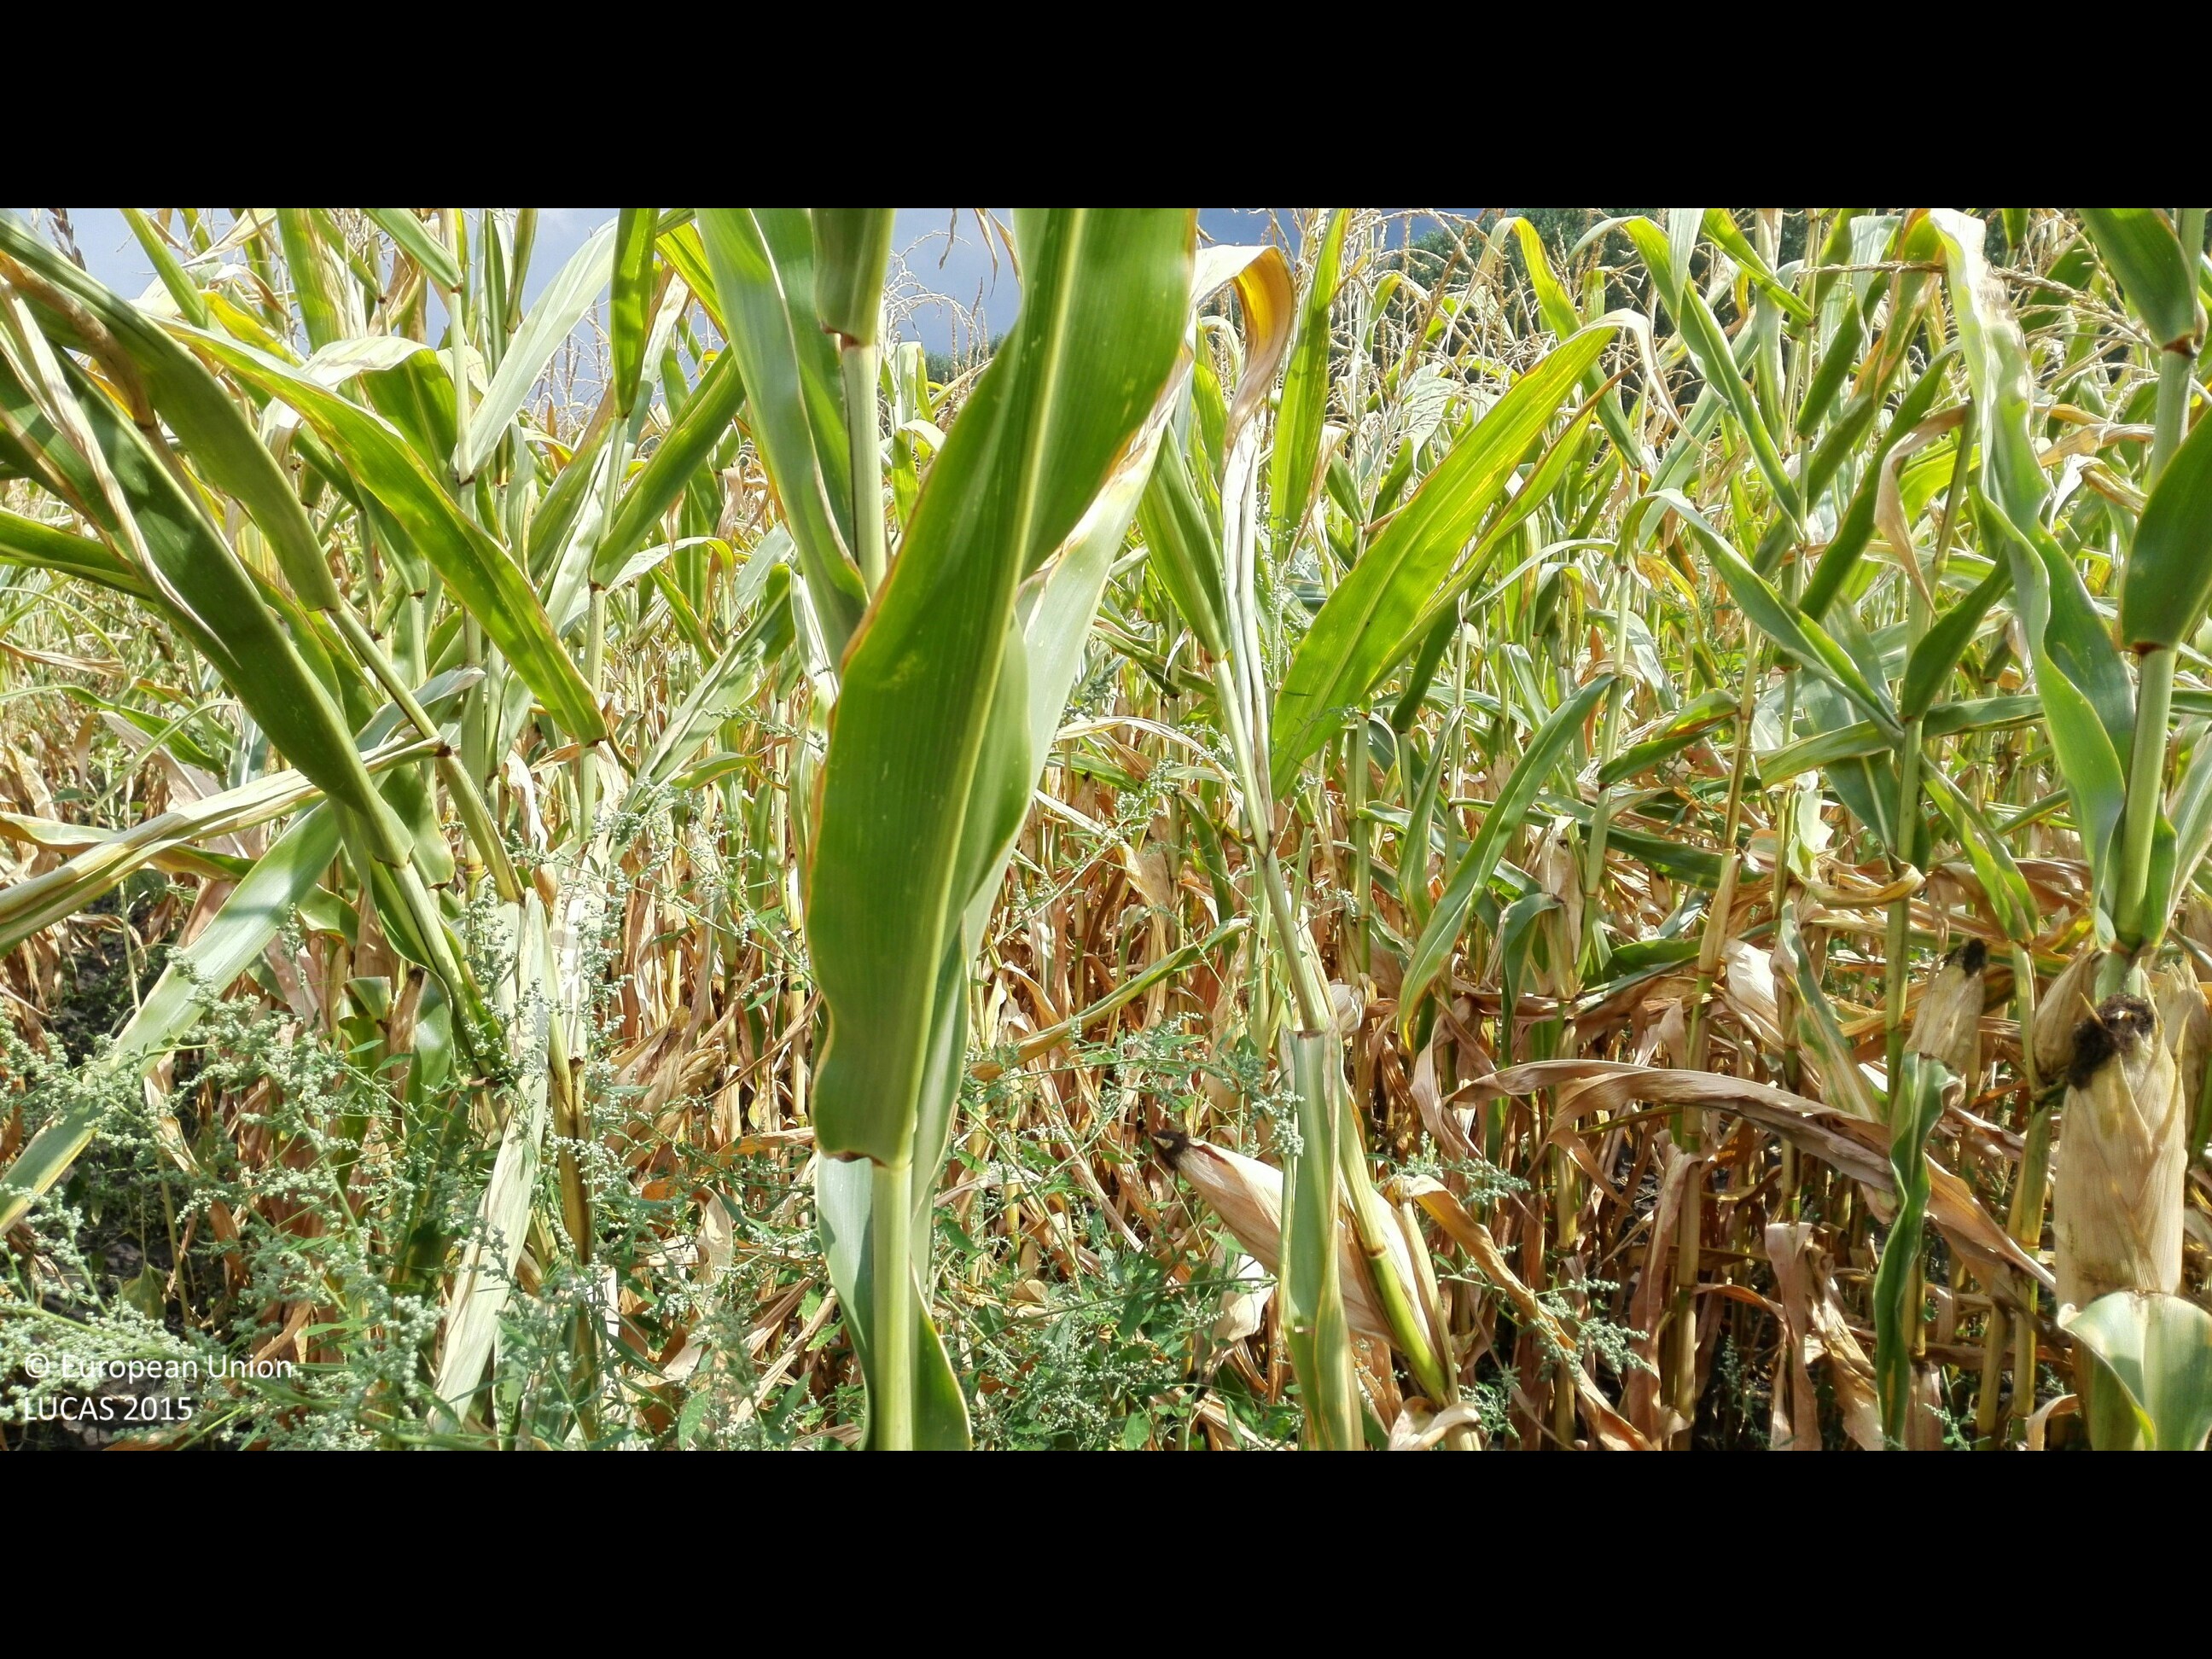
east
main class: Cropland
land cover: Maize
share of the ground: > 75 %
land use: Agriculture (excluding fallow land and kitchen gardens)
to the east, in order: Maize; Tracks; Broadleaved woodland
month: August
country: HU
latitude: 47.3692
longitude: 21.6310
